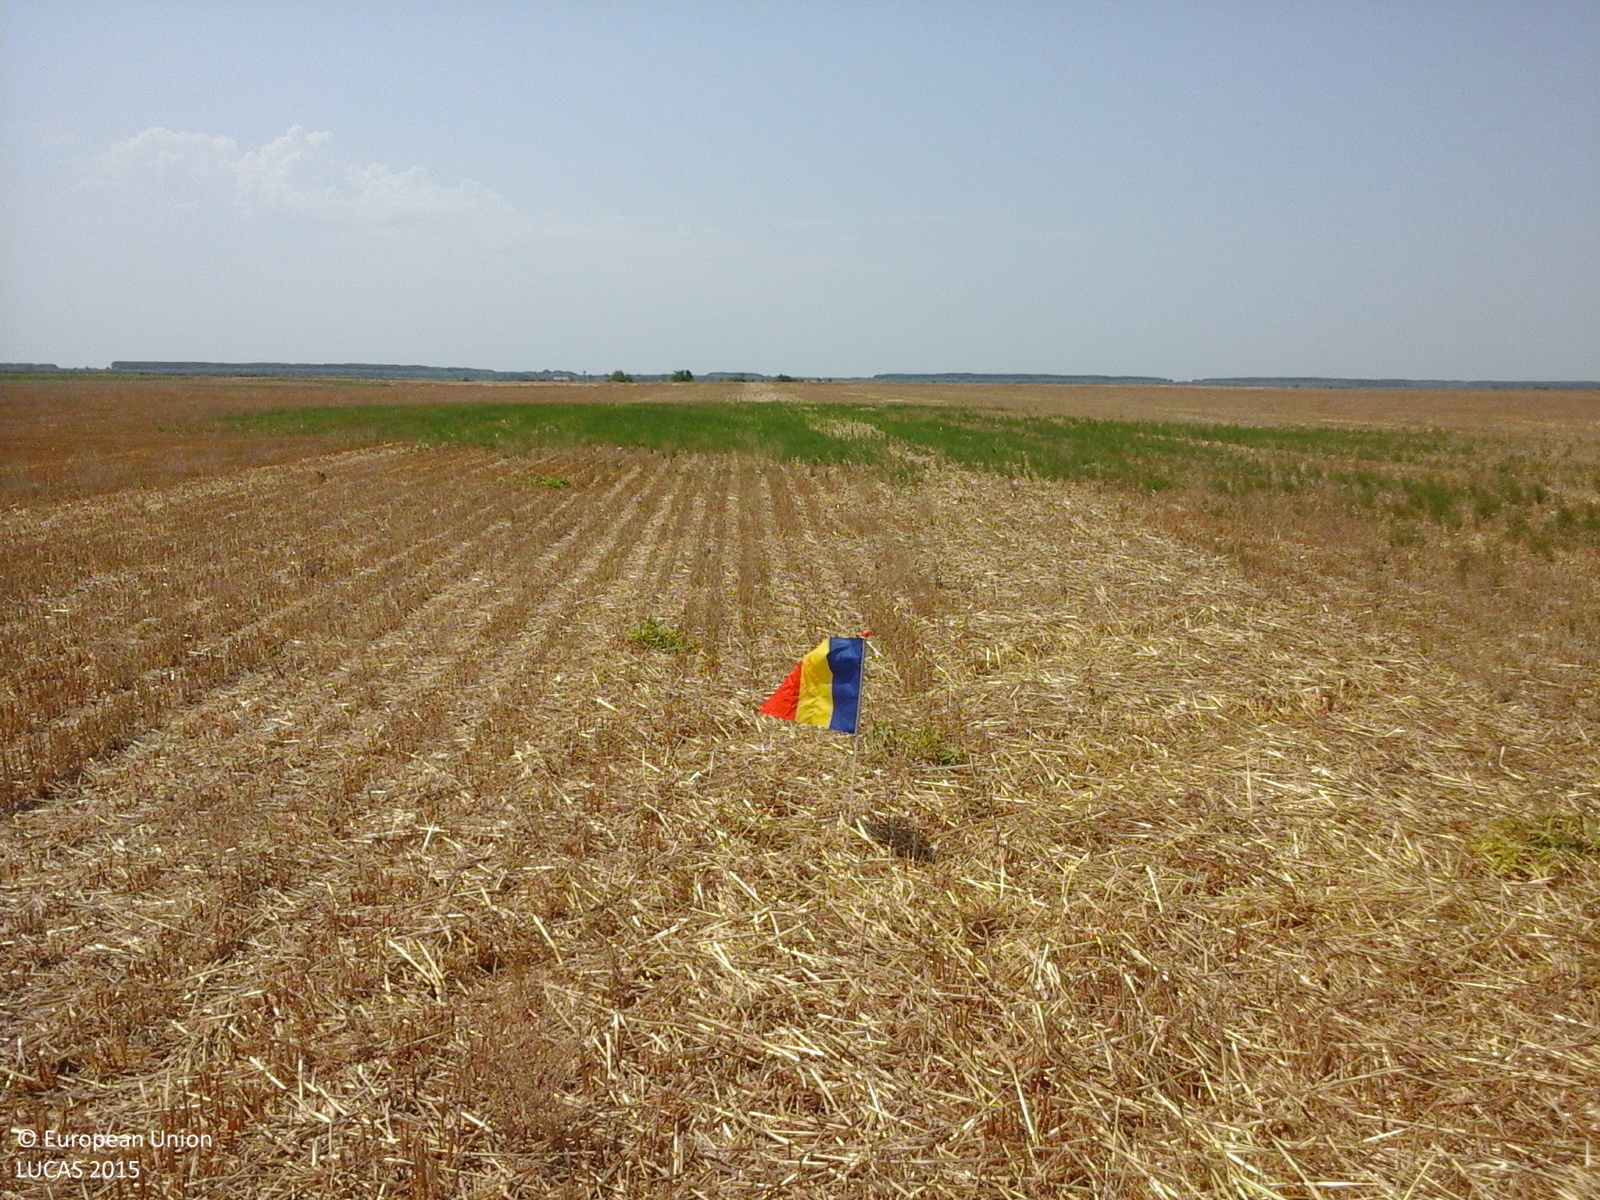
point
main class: Cropland
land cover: Barley
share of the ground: > 75 %
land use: Agriculture (excluding fallow land and kitchen gardens)
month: August
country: RO
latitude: 45.0339
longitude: 27.9718
